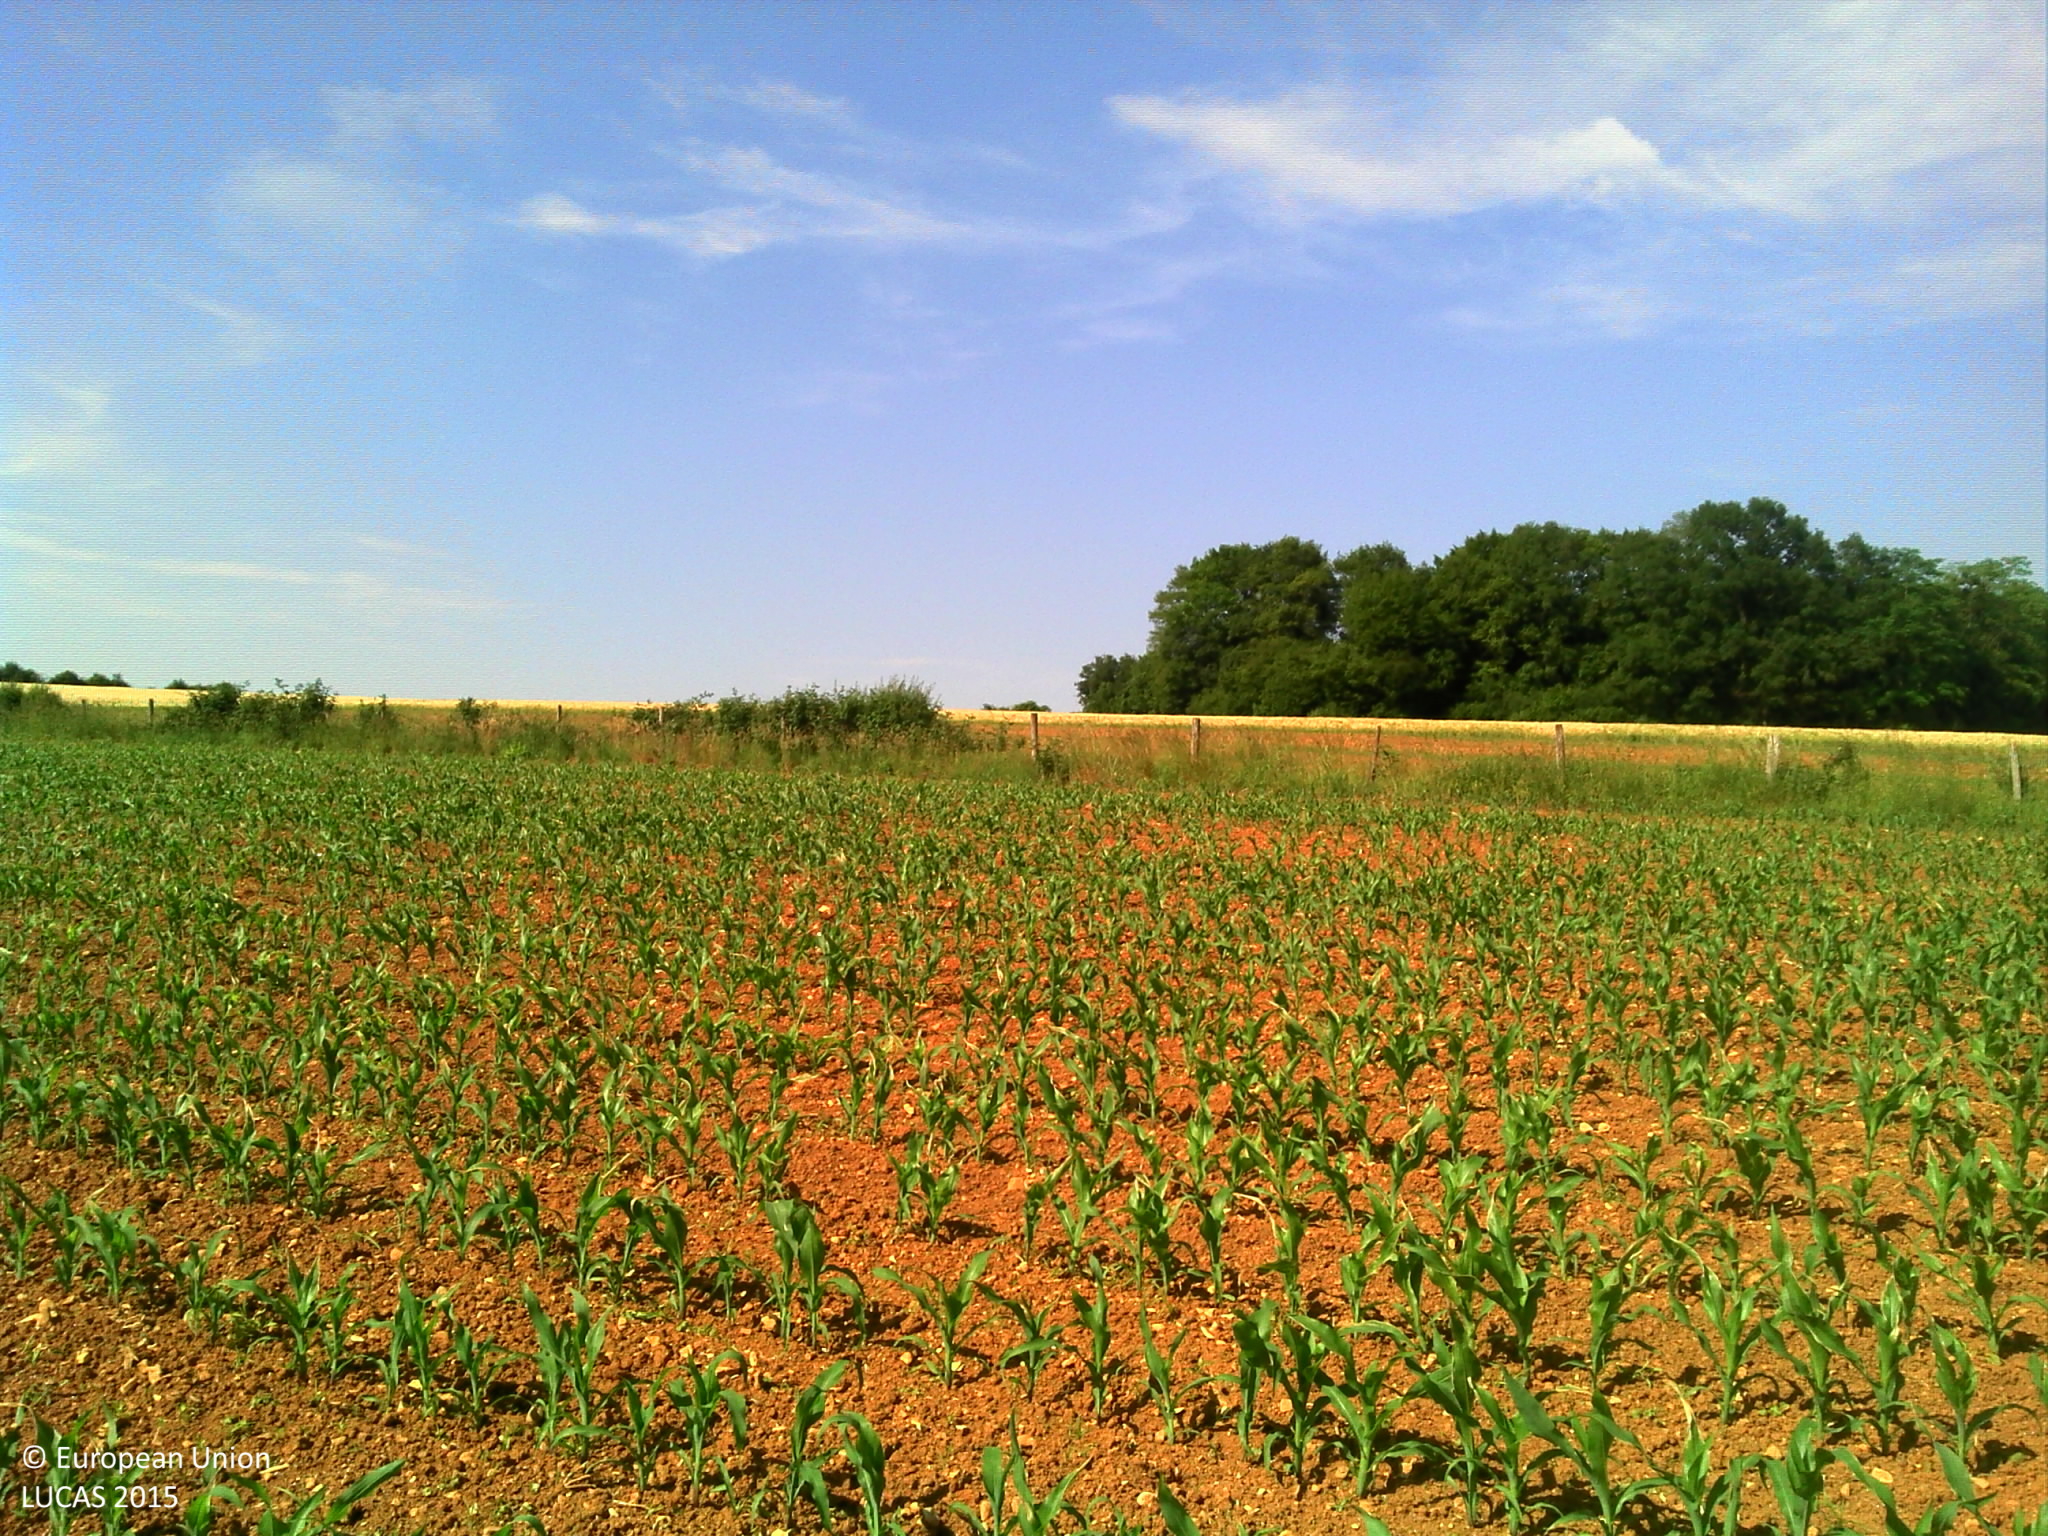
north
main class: Cropland
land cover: Maize
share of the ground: 25 - 50 %
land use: Agriculture (excluding fallow land and kitchen gardens)
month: June
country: FR
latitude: 47.6386
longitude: 6.2878
